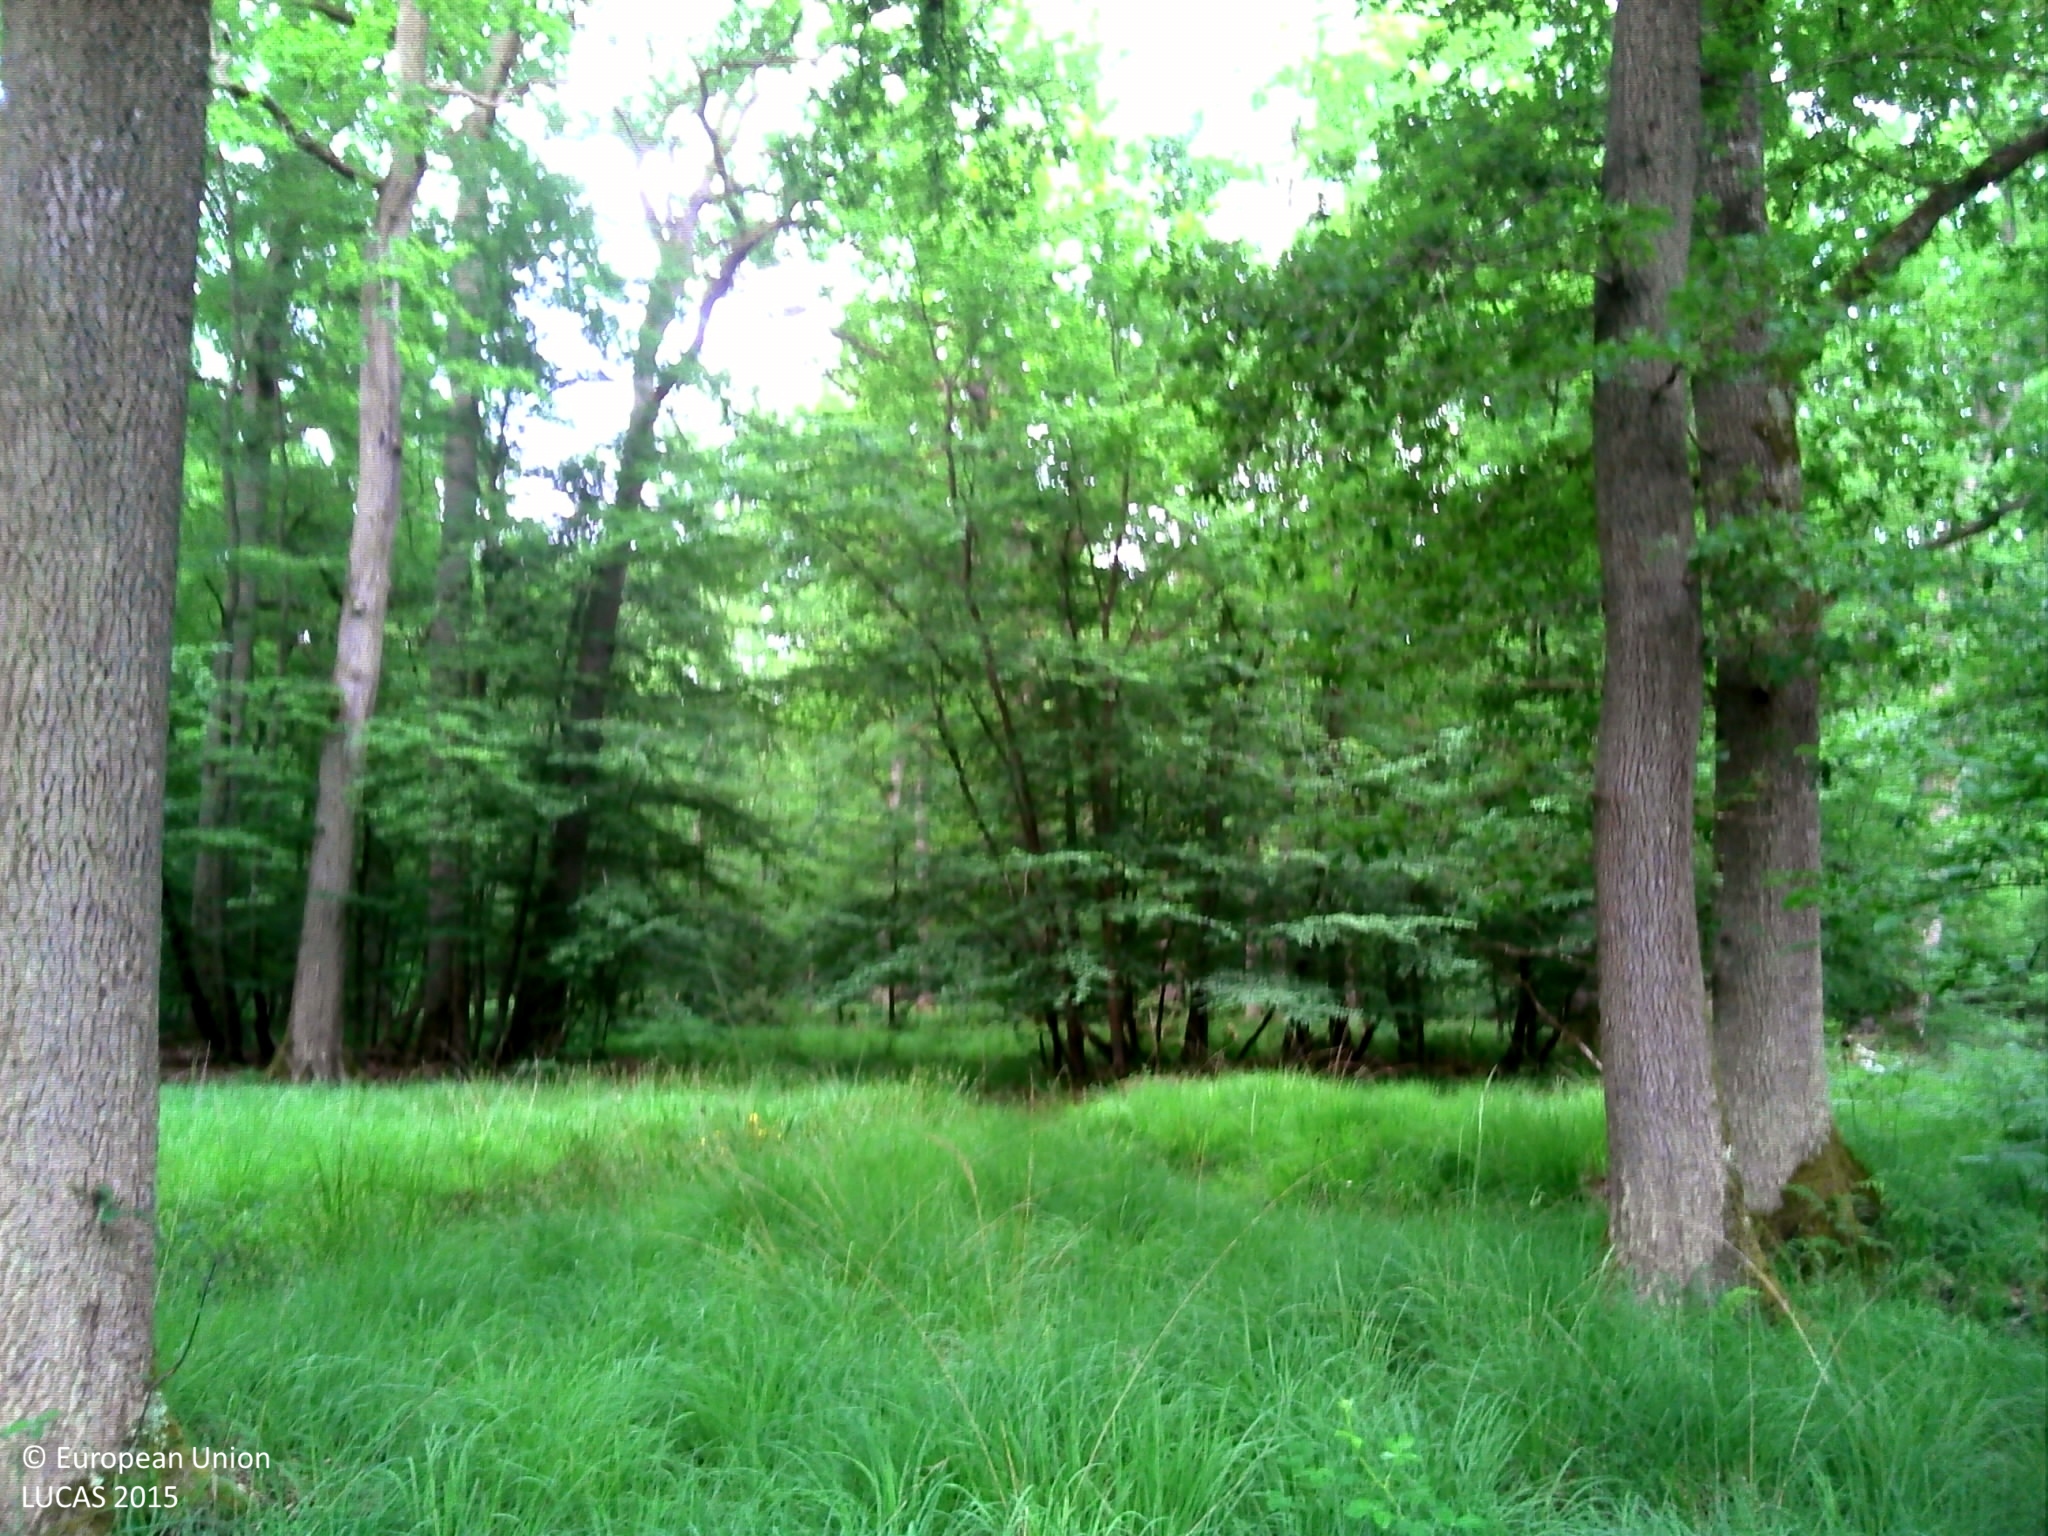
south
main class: Woodland
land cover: Broadleaved woodland
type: acidophilous oak and oak-birch forest
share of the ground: > 75 %
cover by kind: broadleaved forest trees 85 %, herbaceous plants 15 %
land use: Forestry
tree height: > 5 m
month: June
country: FR
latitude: 49.3848
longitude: 2.8958
